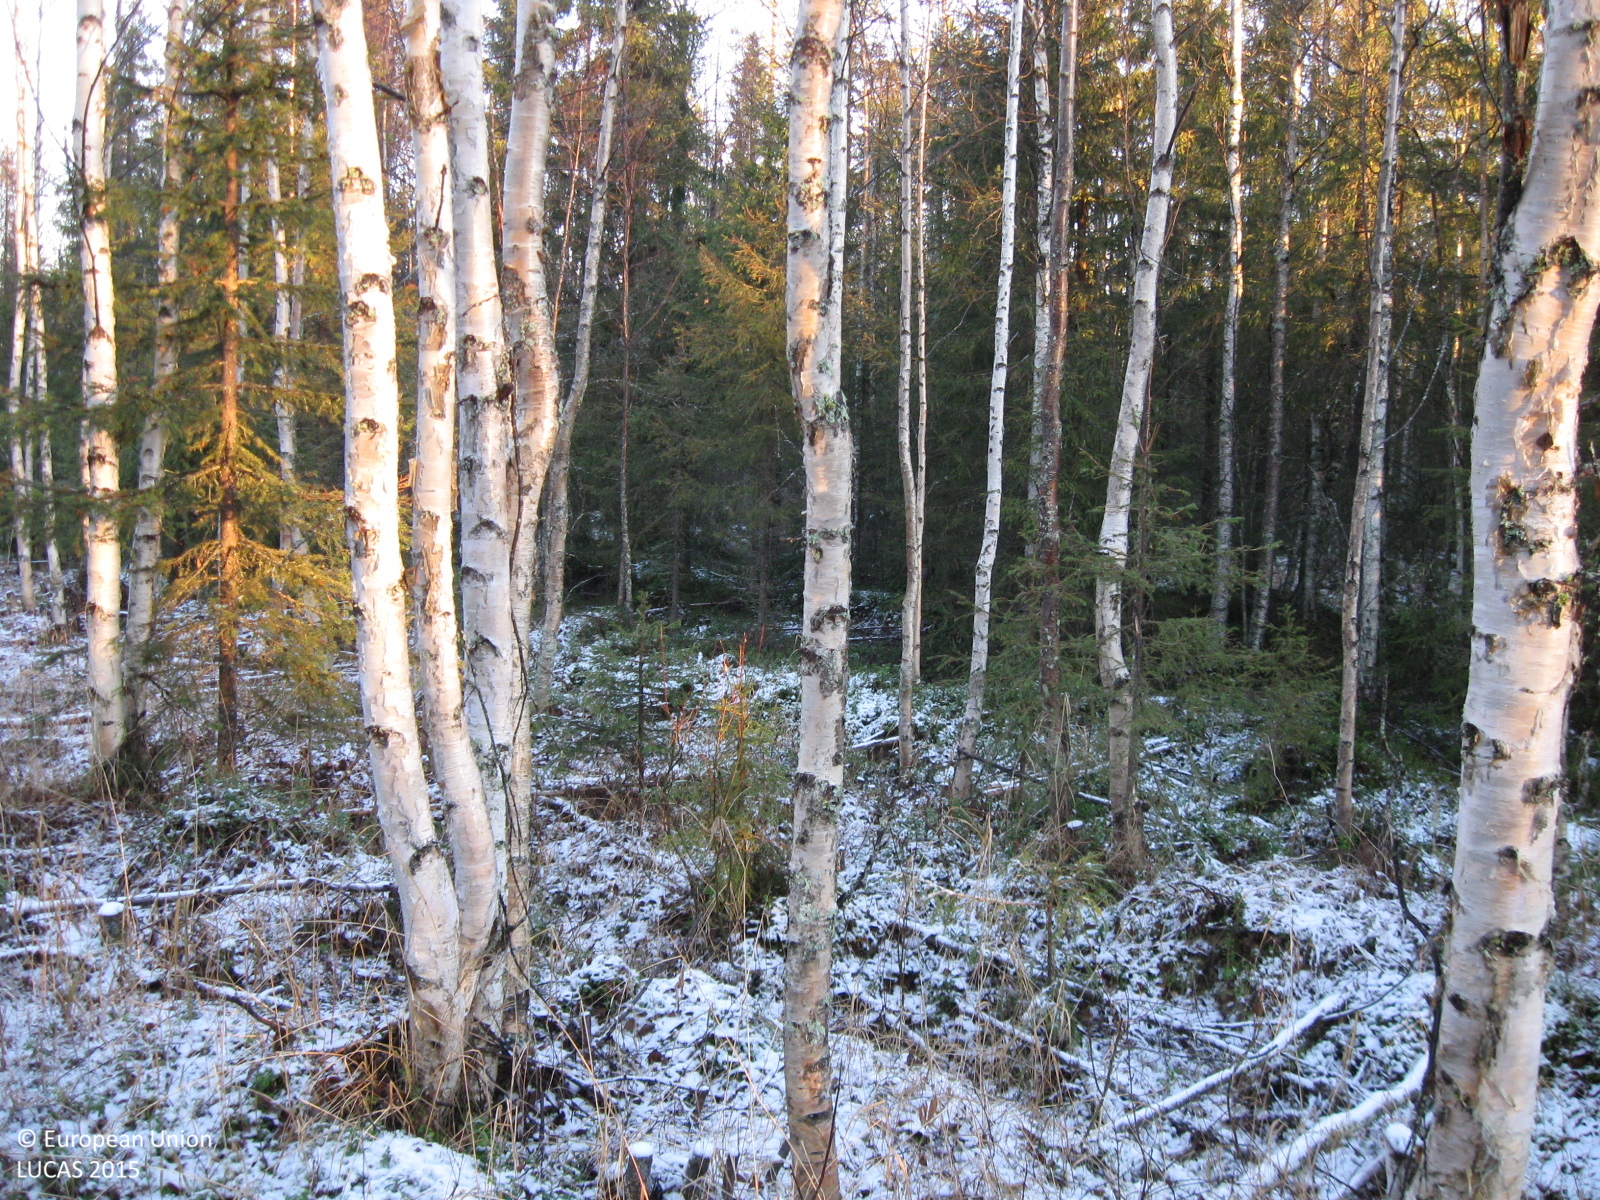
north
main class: Woodland
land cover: Spruce dominated mixed woodland
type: mire and swamp forests
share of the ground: > 75 %
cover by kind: broadleaved forest trees 55 %, coniferous forest trees 20 %, herbaceous plants 15 %, shrubs 10 %
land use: Forestry
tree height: > 5 m
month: October
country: SE
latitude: 66.3094
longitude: 20.8669
